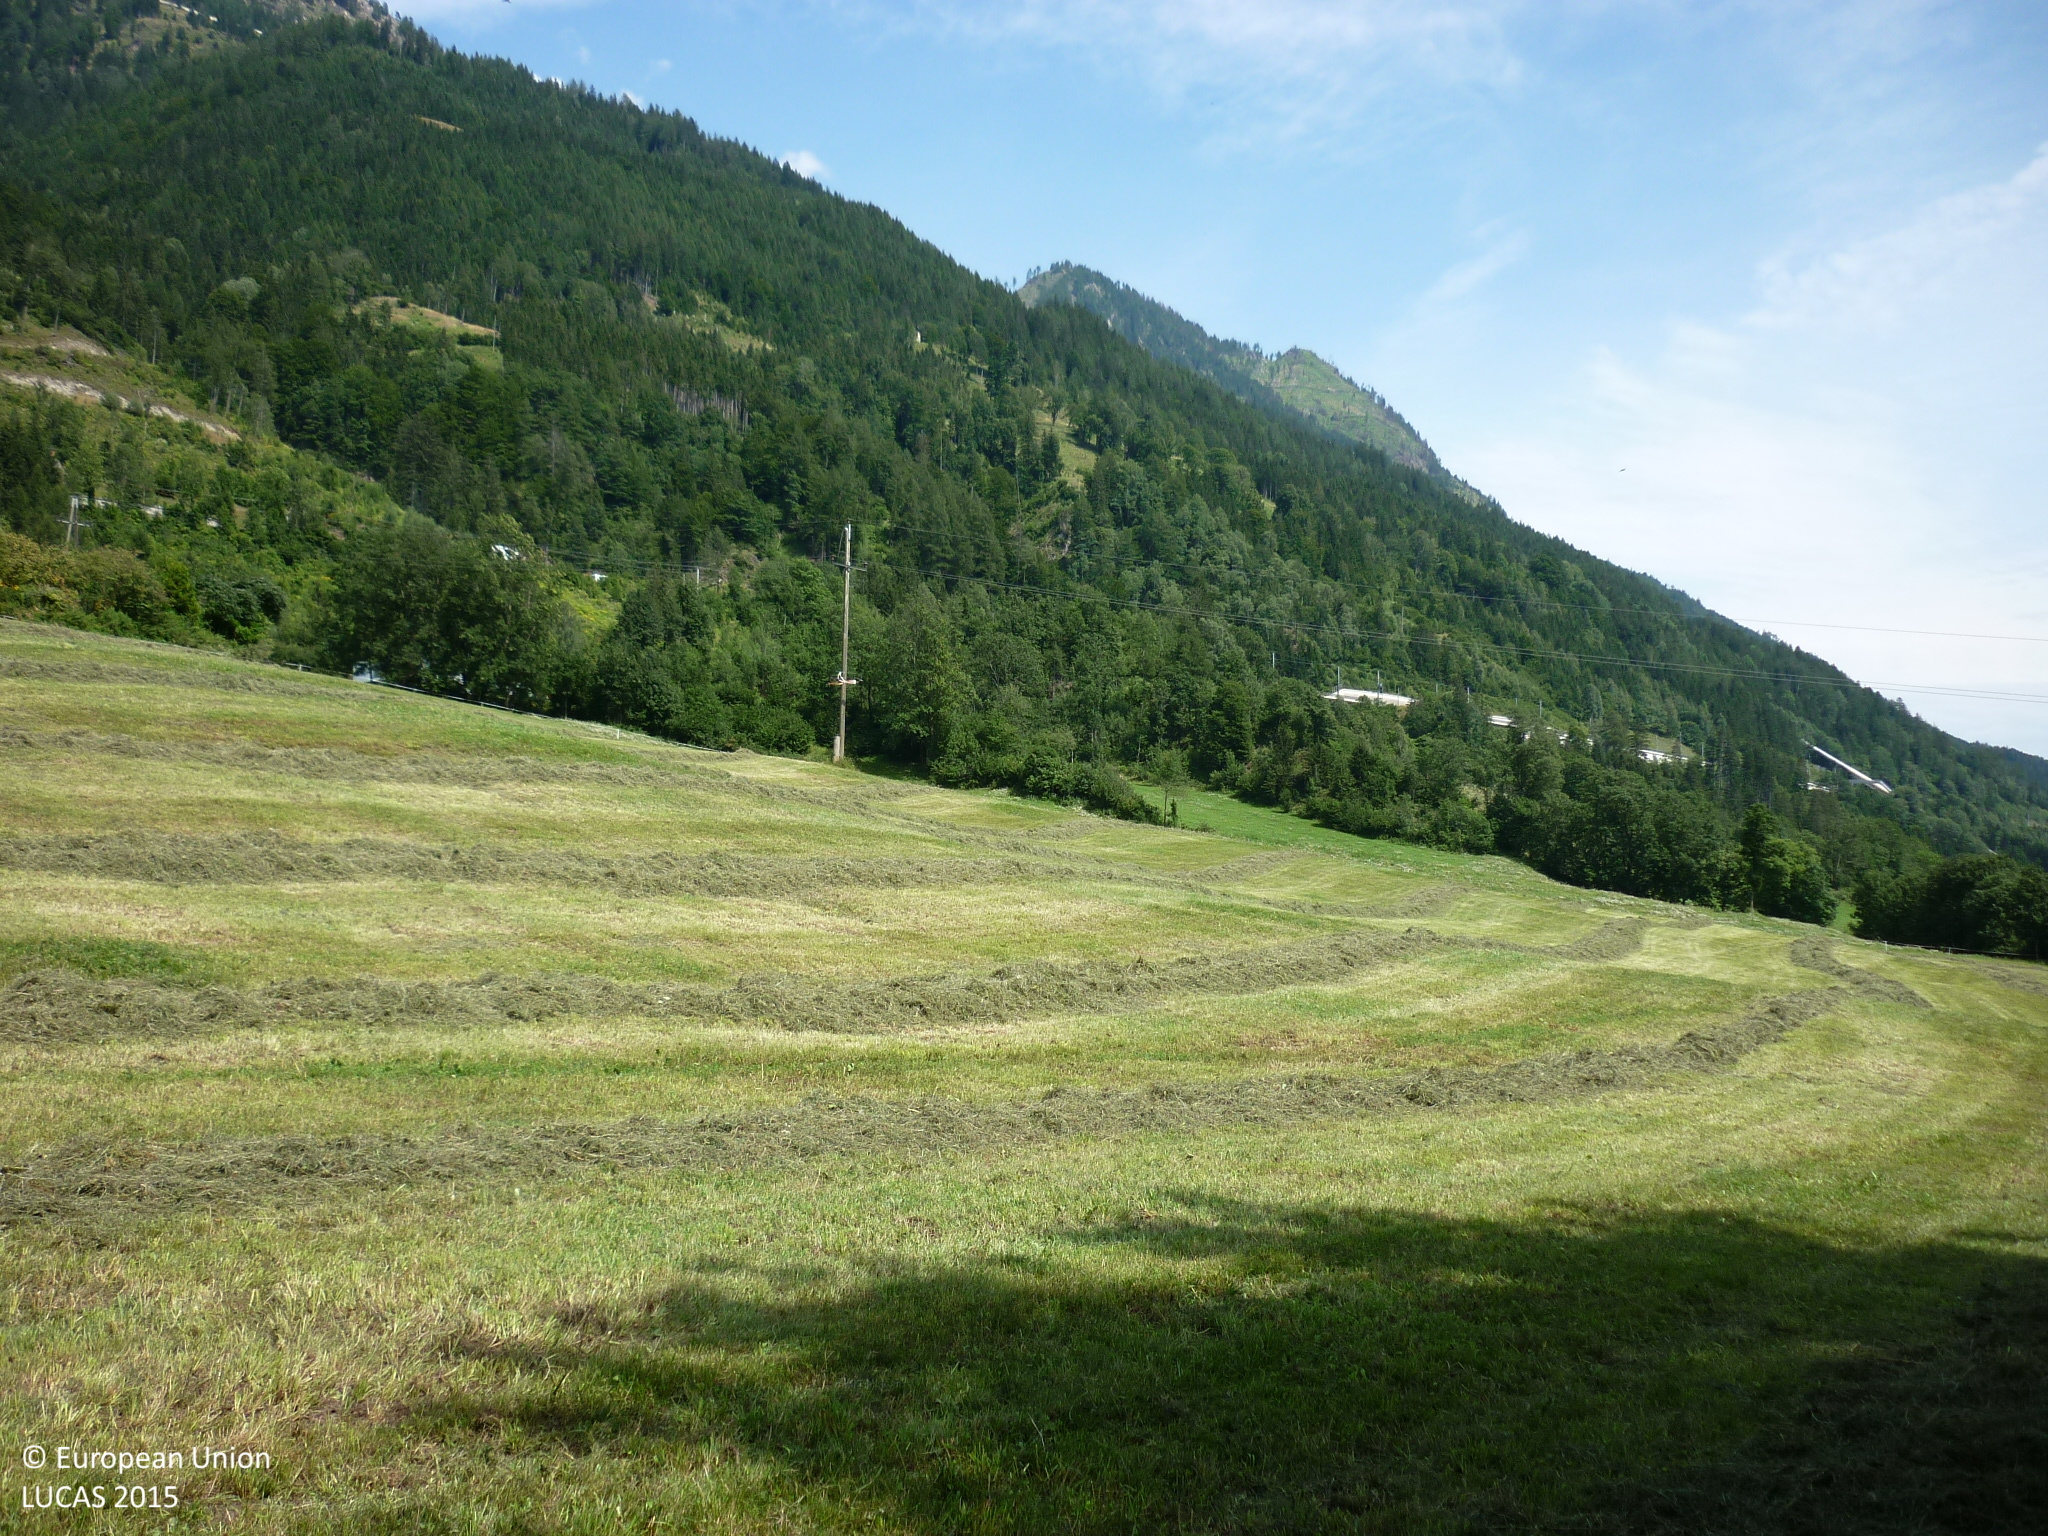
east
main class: Grassland
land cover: Grassland without tree/shrub cover
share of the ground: > 75 %
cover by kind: herbaceous plants 100 %
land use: Agriculture (excluding fallow land and kitchen gardens)
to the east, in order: Grassland without tree/shrub cover; Electric lines; Grassland without tree/shrub cover; Fences; Grassland without tree/shrub cover
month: August
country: AT
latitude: 46.8766
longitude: 13.3171
